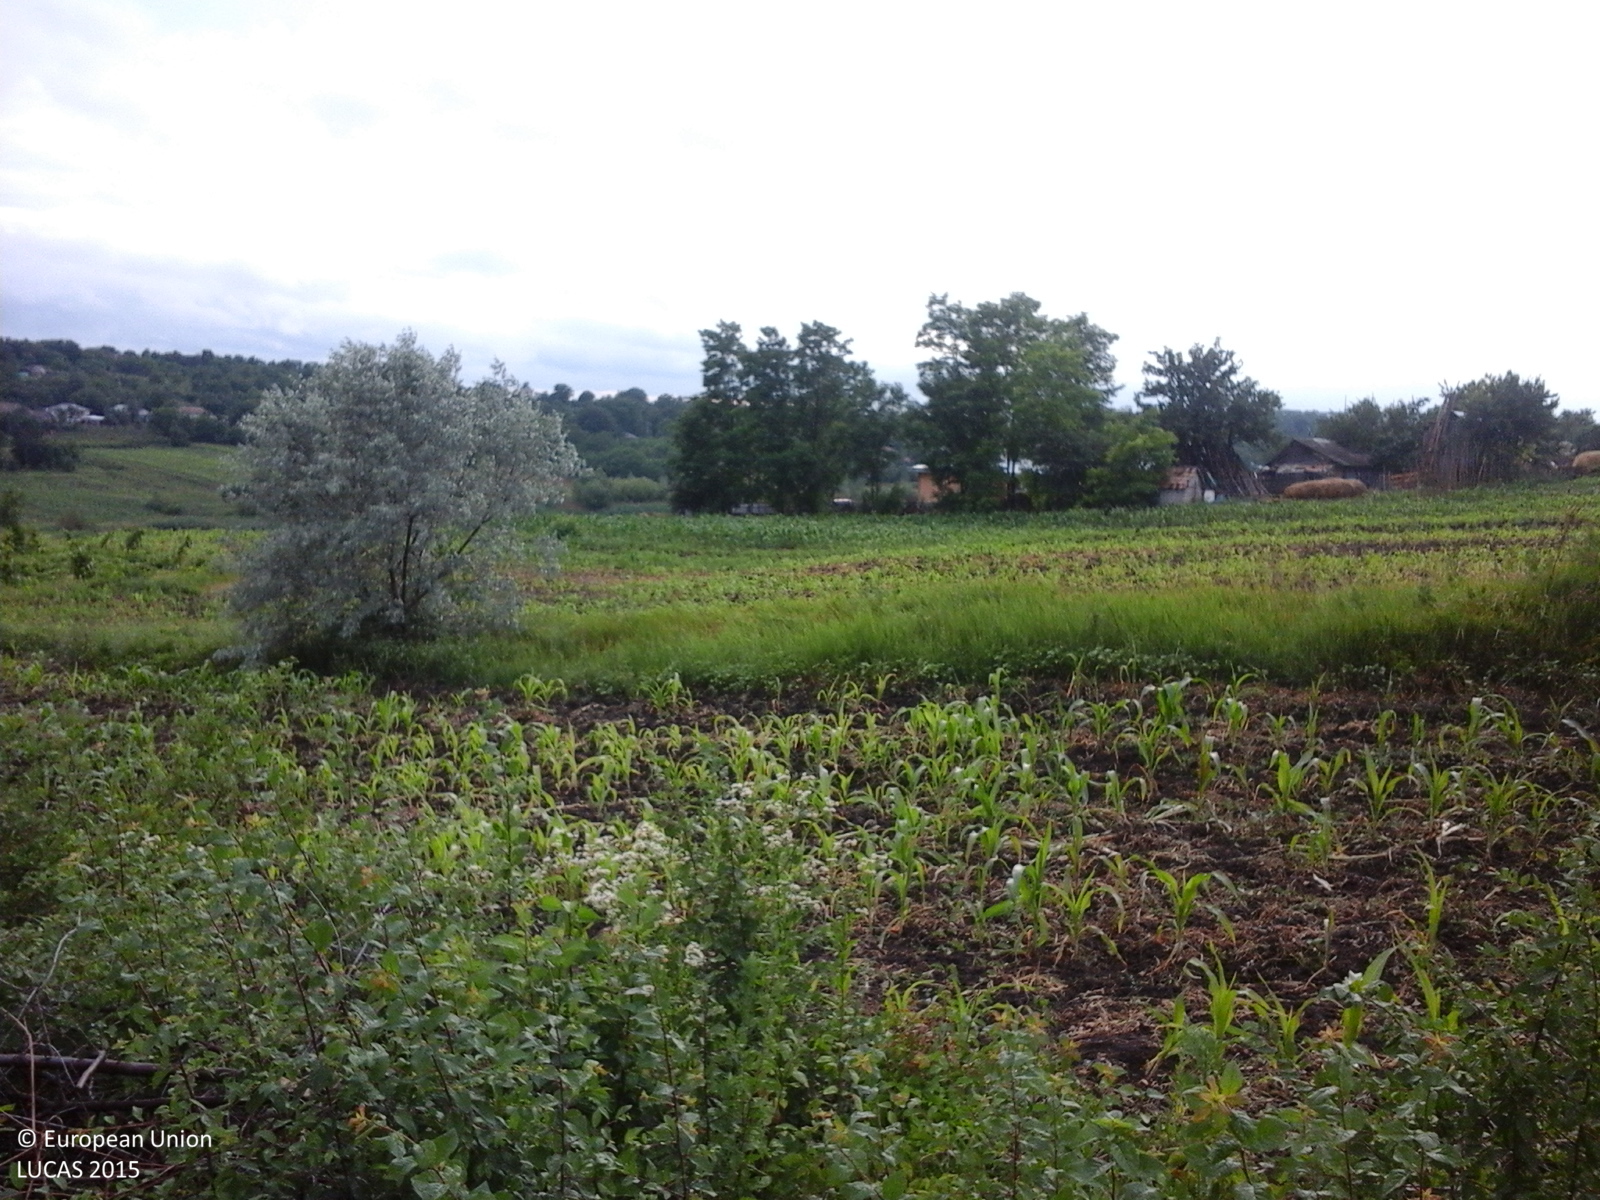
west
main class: Cropland
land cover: Vineyards
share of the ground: 50 - 75 %
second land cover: Other bare soil
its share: > 75 %
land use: Agriculture (excluding fallow land and kitchen gardens)
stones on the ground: < 10 %
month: June
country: RO
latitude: 47.6404
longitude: 27.0226
